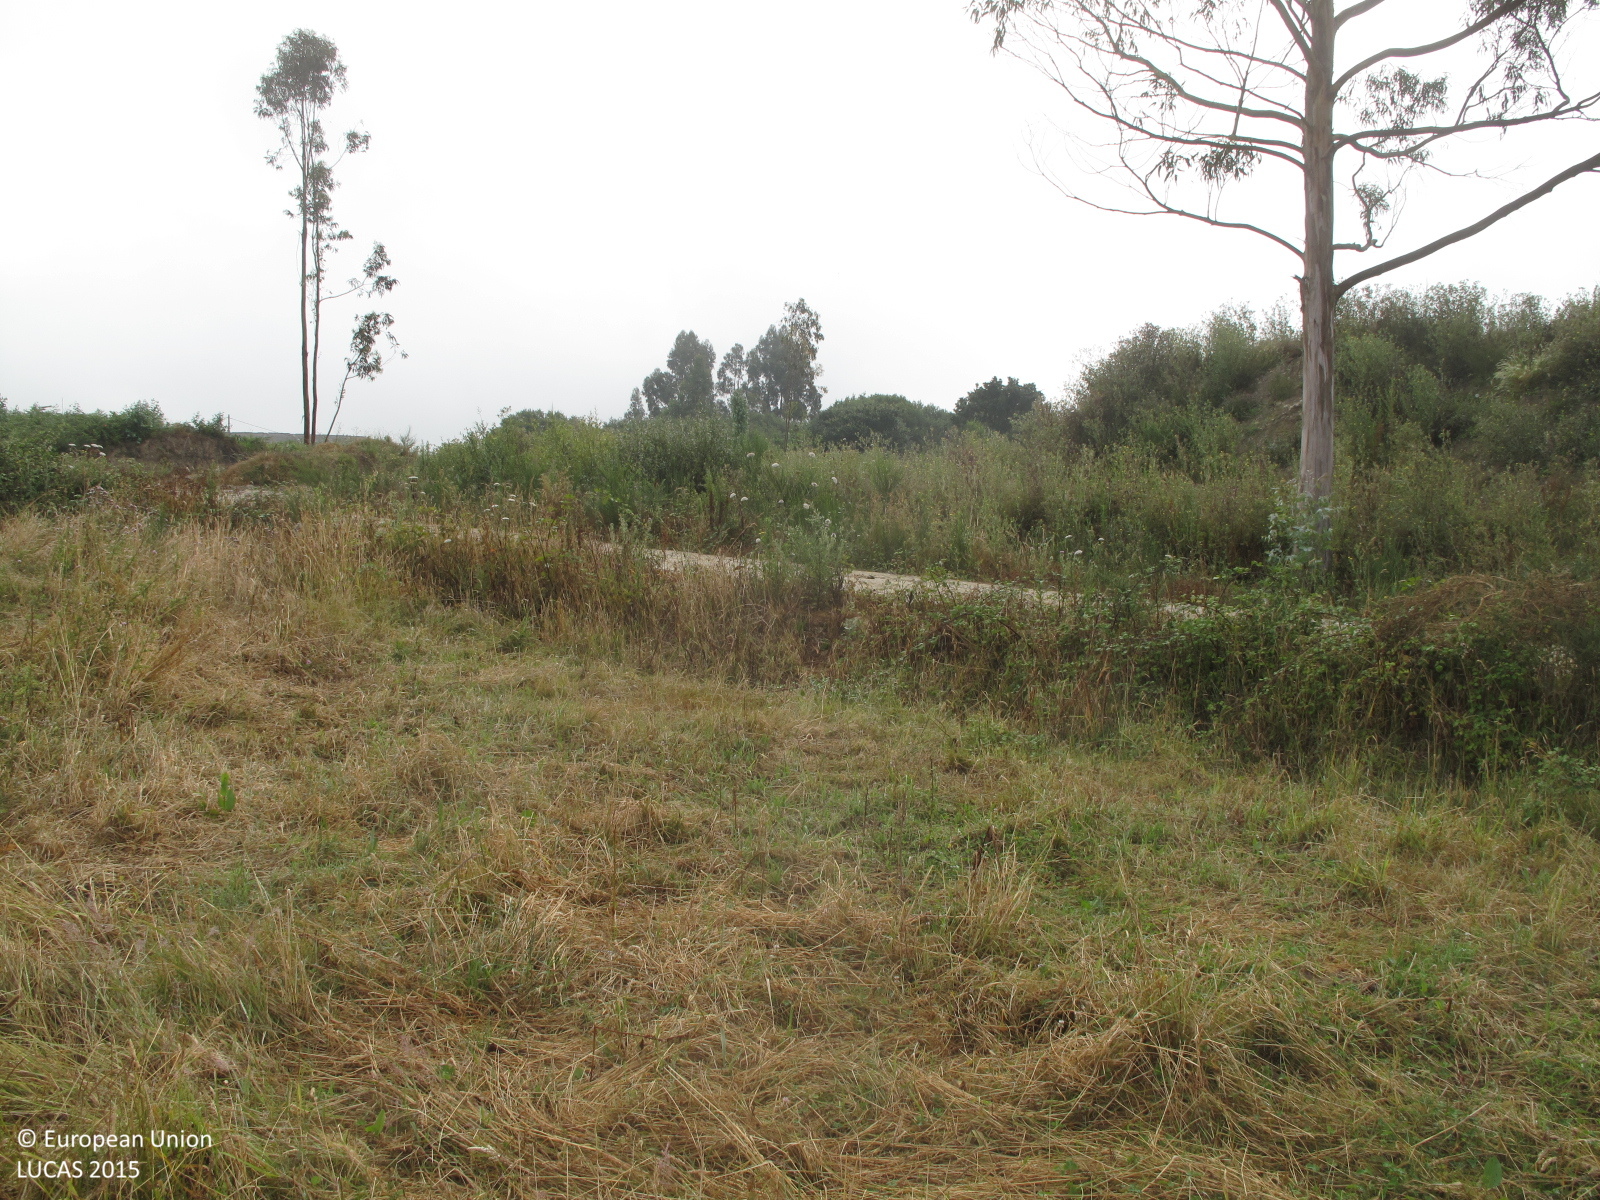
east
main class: Grassland
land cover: Grassland without tree/shrub cover
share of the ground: > 75 %
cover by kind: herbaceous plants 100 %
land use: Agriculture (excluding fallow land and kitchen gardens)
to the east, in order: Grassland without tree/shrub cover; Tracks; Grassland with sparse tree/shrub cover; Broadleaved woodland; Shrubland without tree cover; Grassland without tree/shrub cover; Shruby margins; Tracks
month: July
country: ES
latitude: 43.5307
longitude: -8.2310
